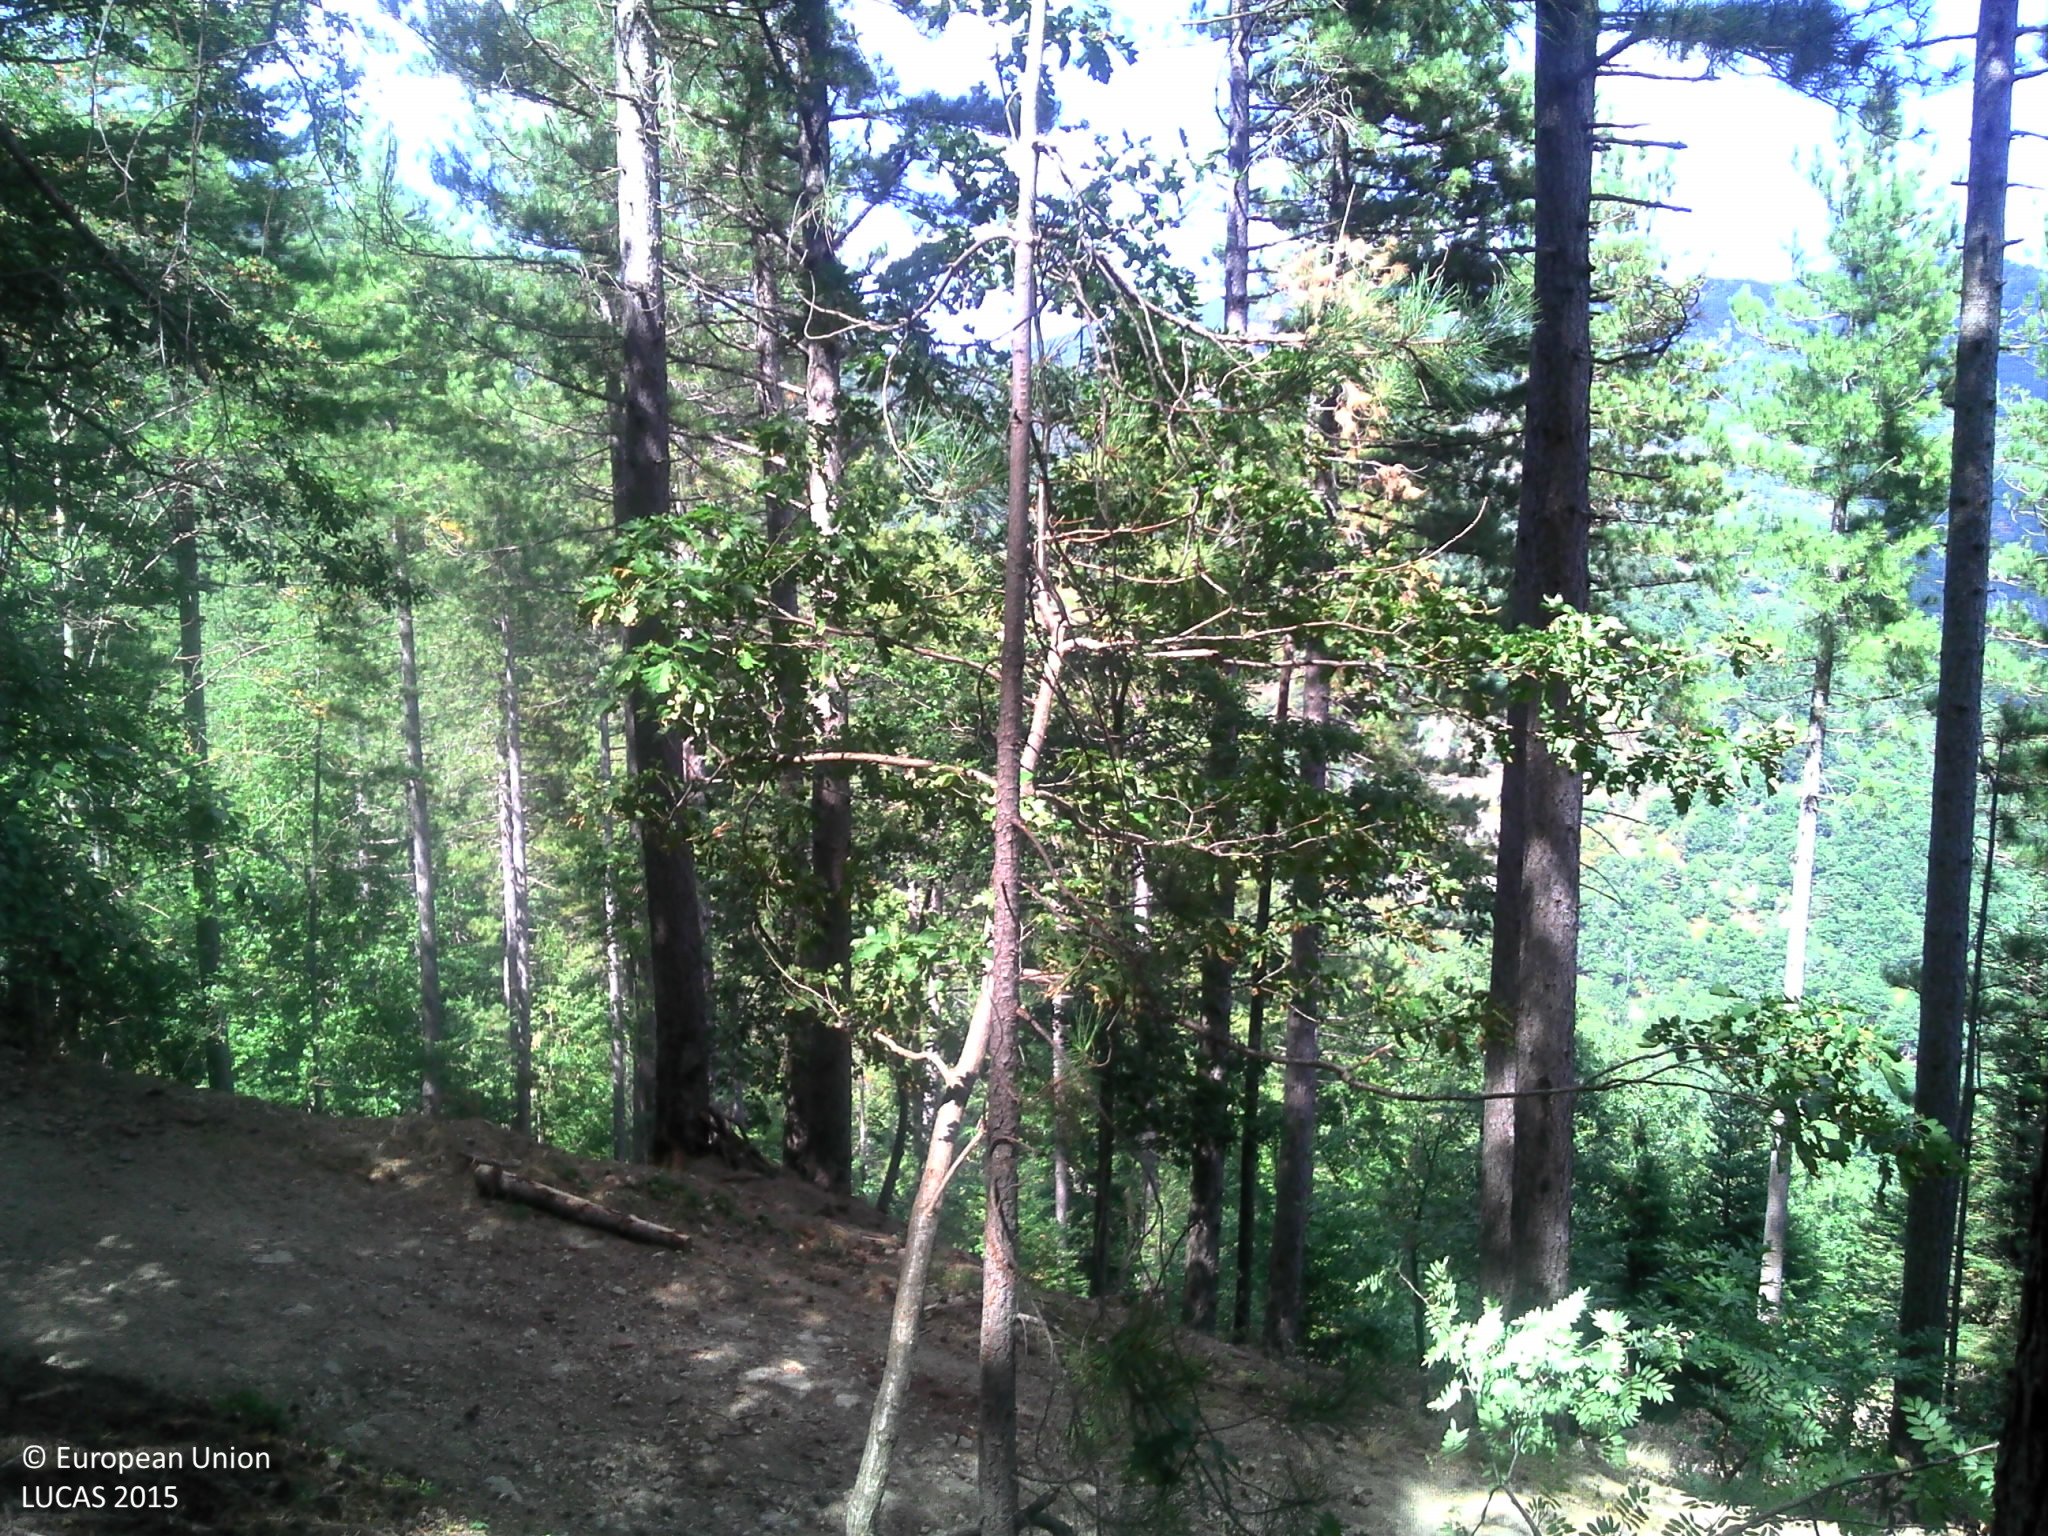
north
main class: Woodland
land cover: Spruce dominated mixed woodland
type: mountainous beech forest
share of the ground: > 75 %
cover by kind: coniferous forest trees 45 %, broadleaved forest trees 30 %, unconsolidated bare surface 15 %, herbaceous plants 10 %
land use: Forestry
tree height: > 5 m
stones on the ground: 10 - 25 %
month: August
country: FR
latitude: 44.7353
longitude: 4.2853
